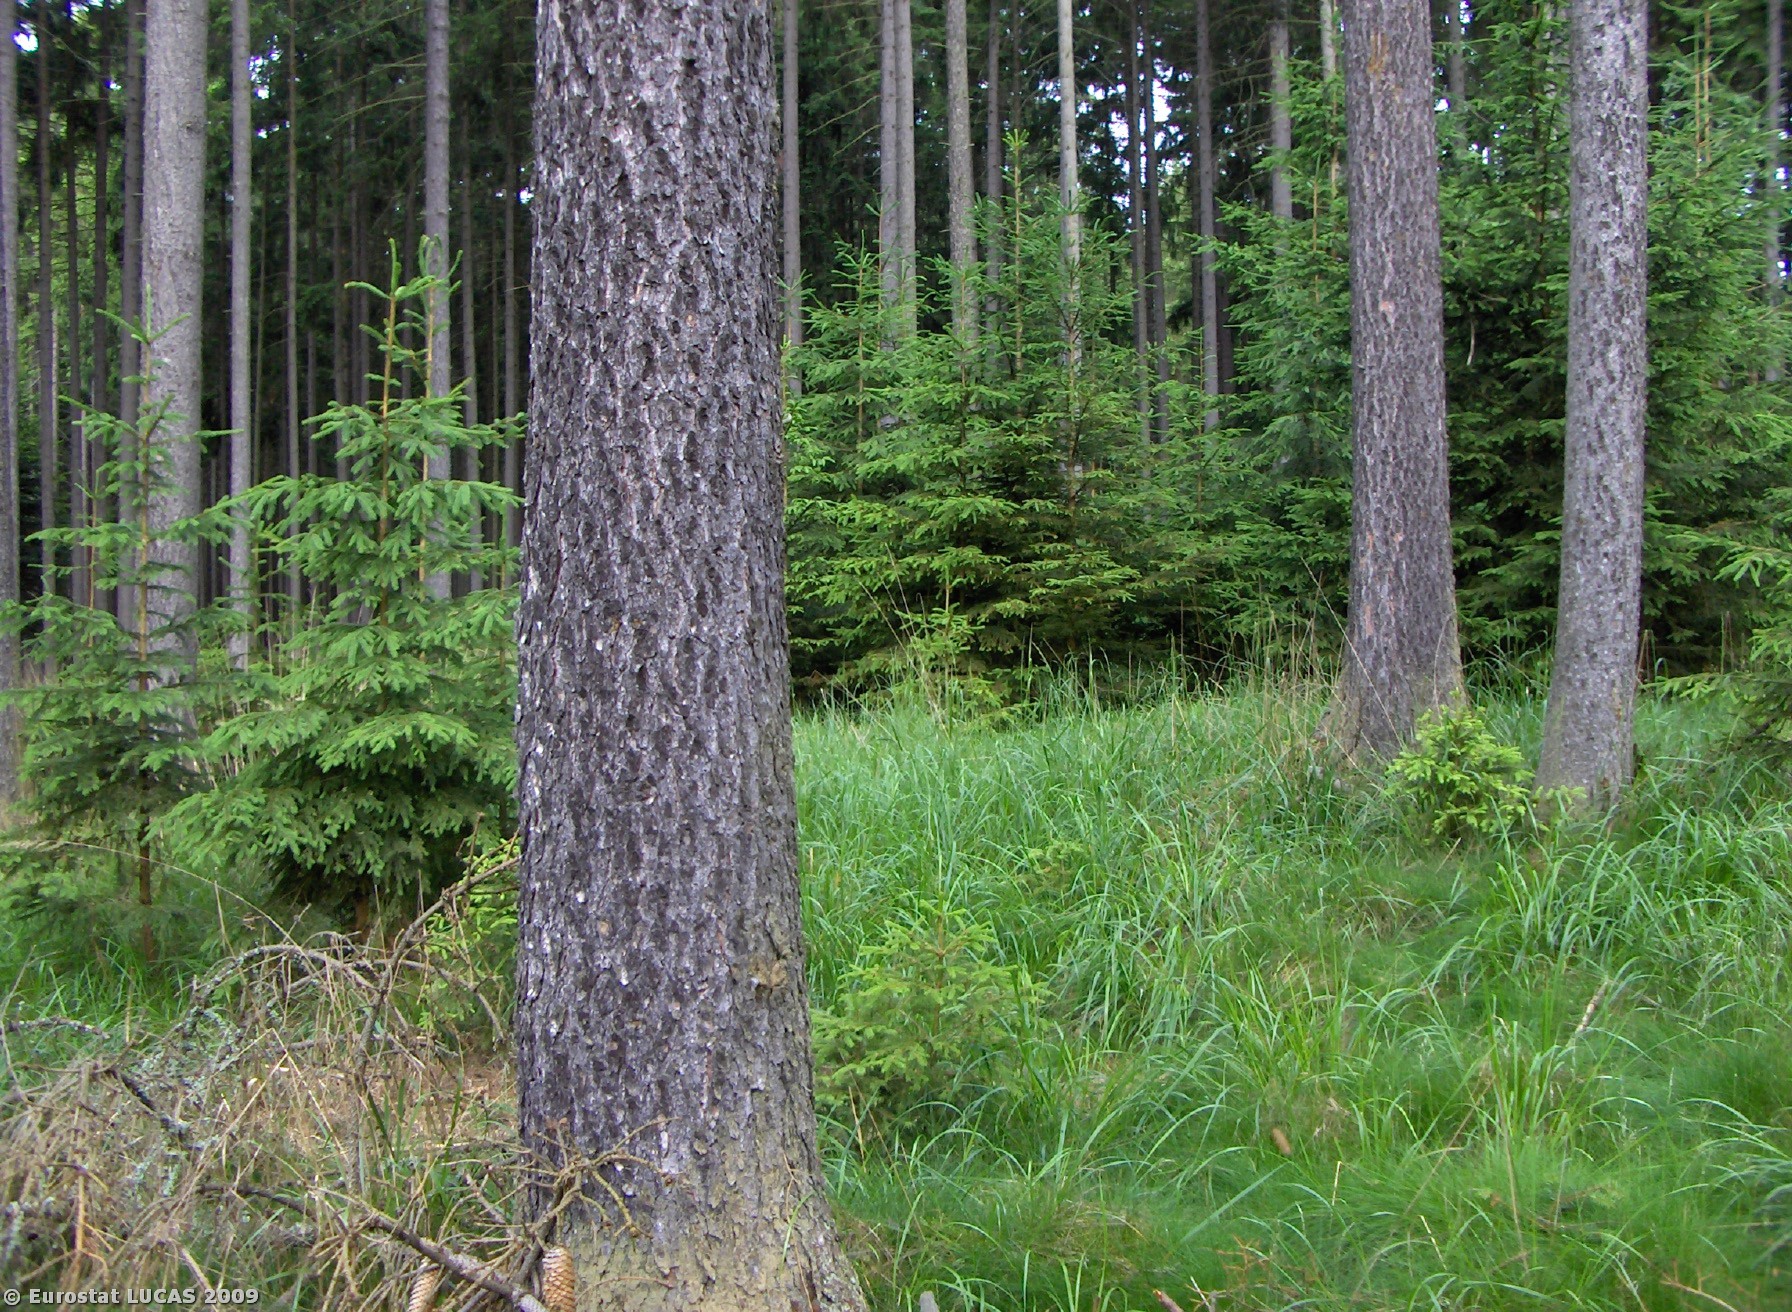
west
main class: Woodland
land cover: Coniferous woodland
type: hemiboreal forest and nemoral coniferous forest and mixed broadleaved-coniferous forest
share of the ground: > 75 %
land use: Forestry
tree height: > 5 m
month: June
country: CZ
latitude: 49.1012
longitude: 14.1234
